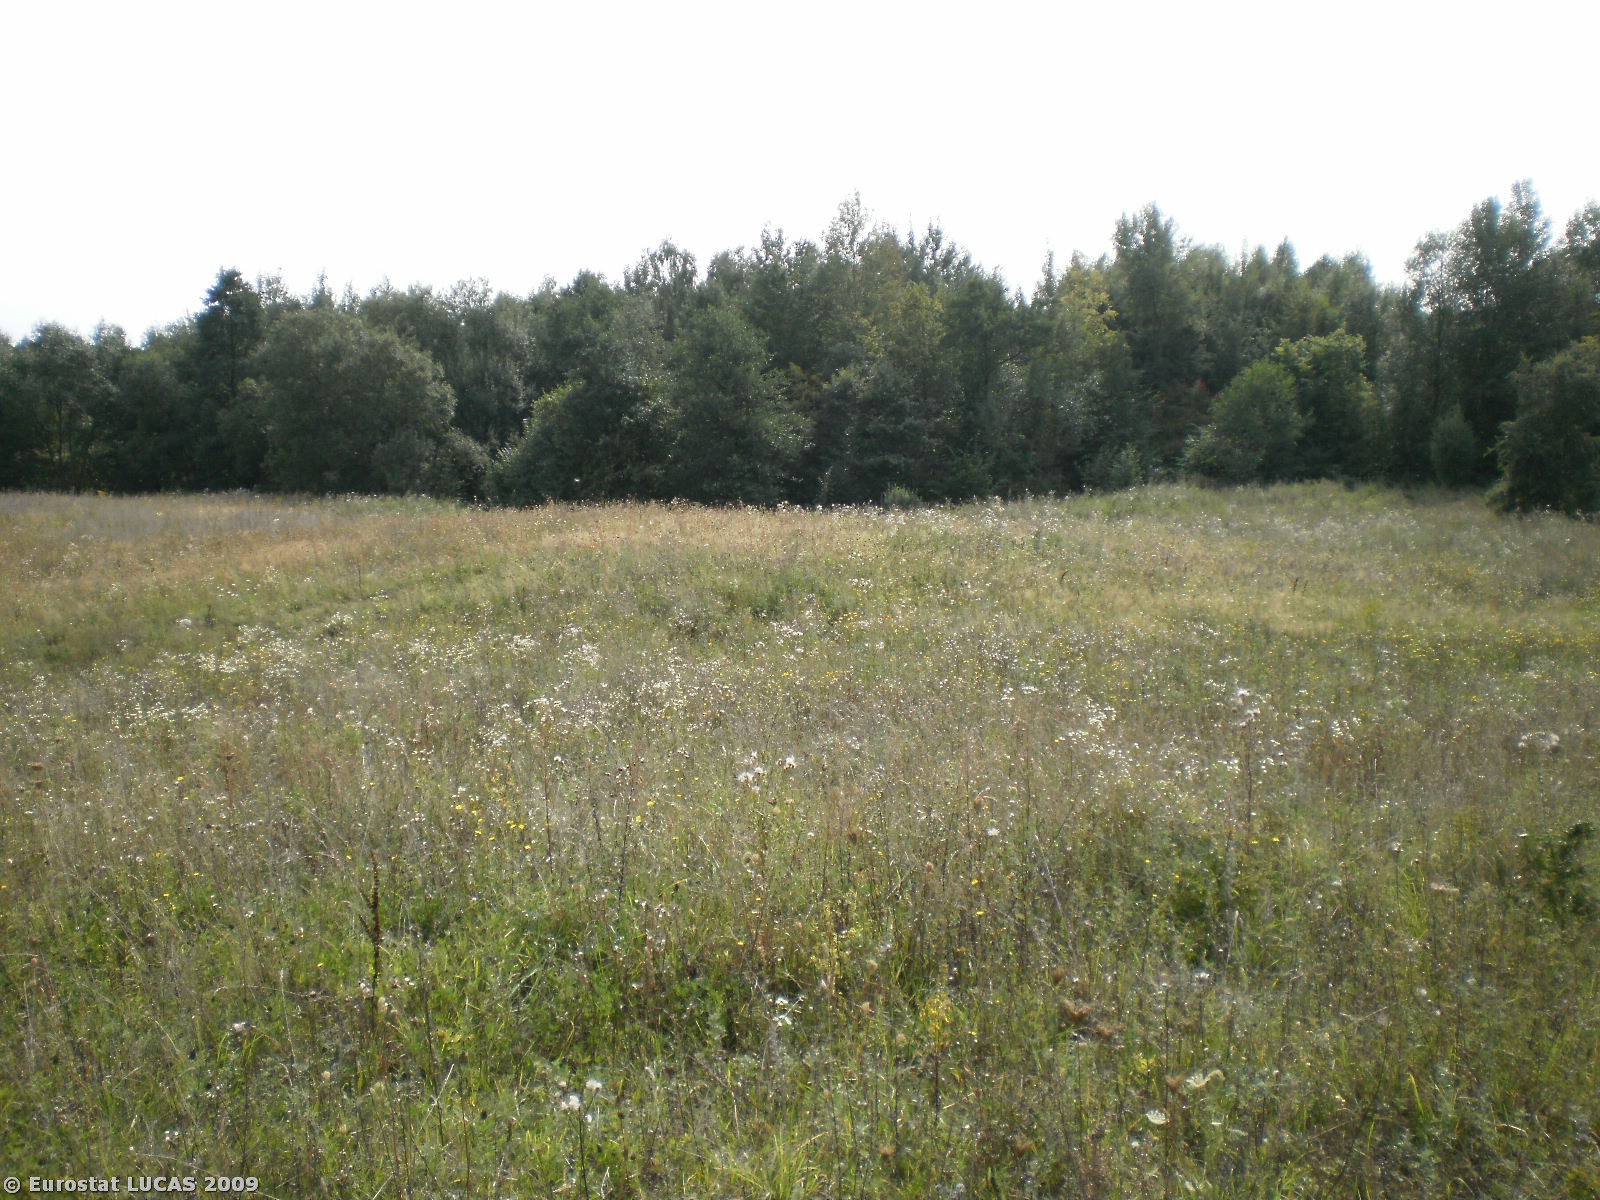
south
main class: Grassland
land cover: Grassland without tree/shrub cover
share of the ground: > 75 %
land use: Fallow land
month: September
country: PL
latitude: 53.8750
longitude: 21.4411
